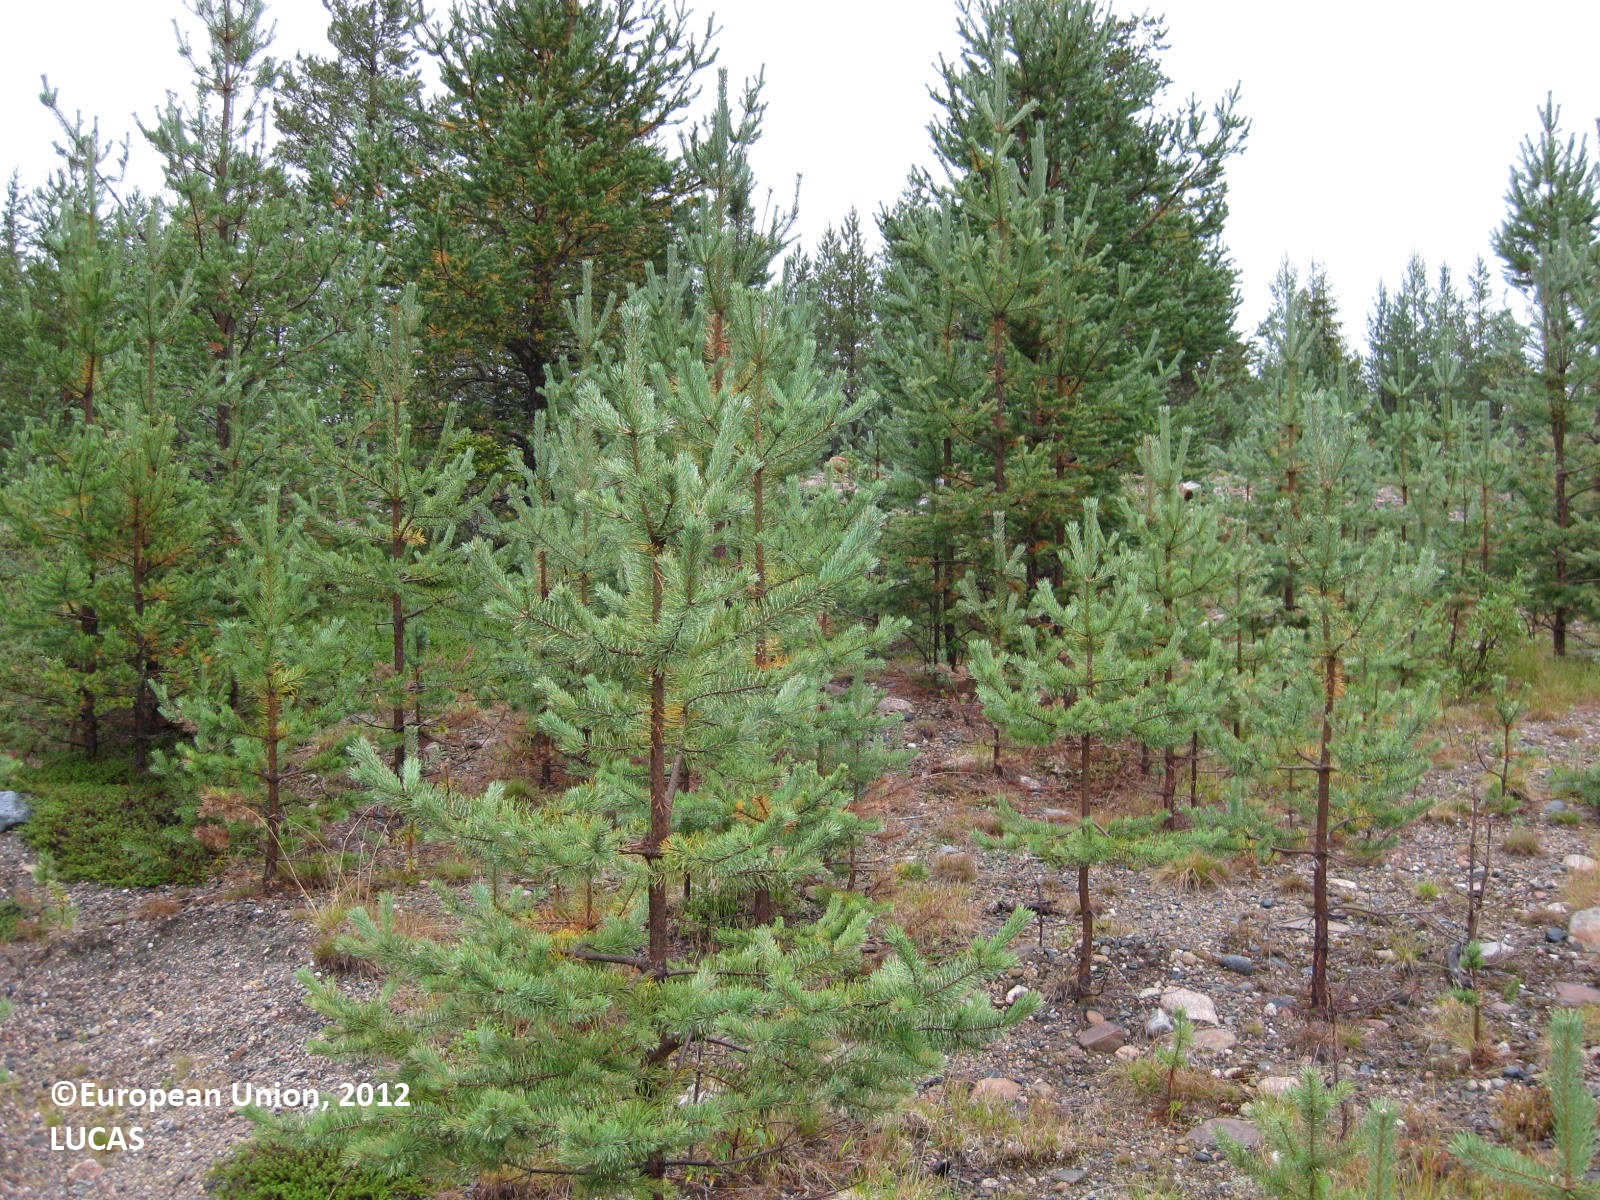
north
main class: Woodland
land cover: Pine dominated coniferous woodland
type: boreal forest
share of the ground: 10 - 25 %
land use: Forestry
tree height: < 5 m
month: August
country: FI
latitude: 66.1445
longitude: 28.4301
